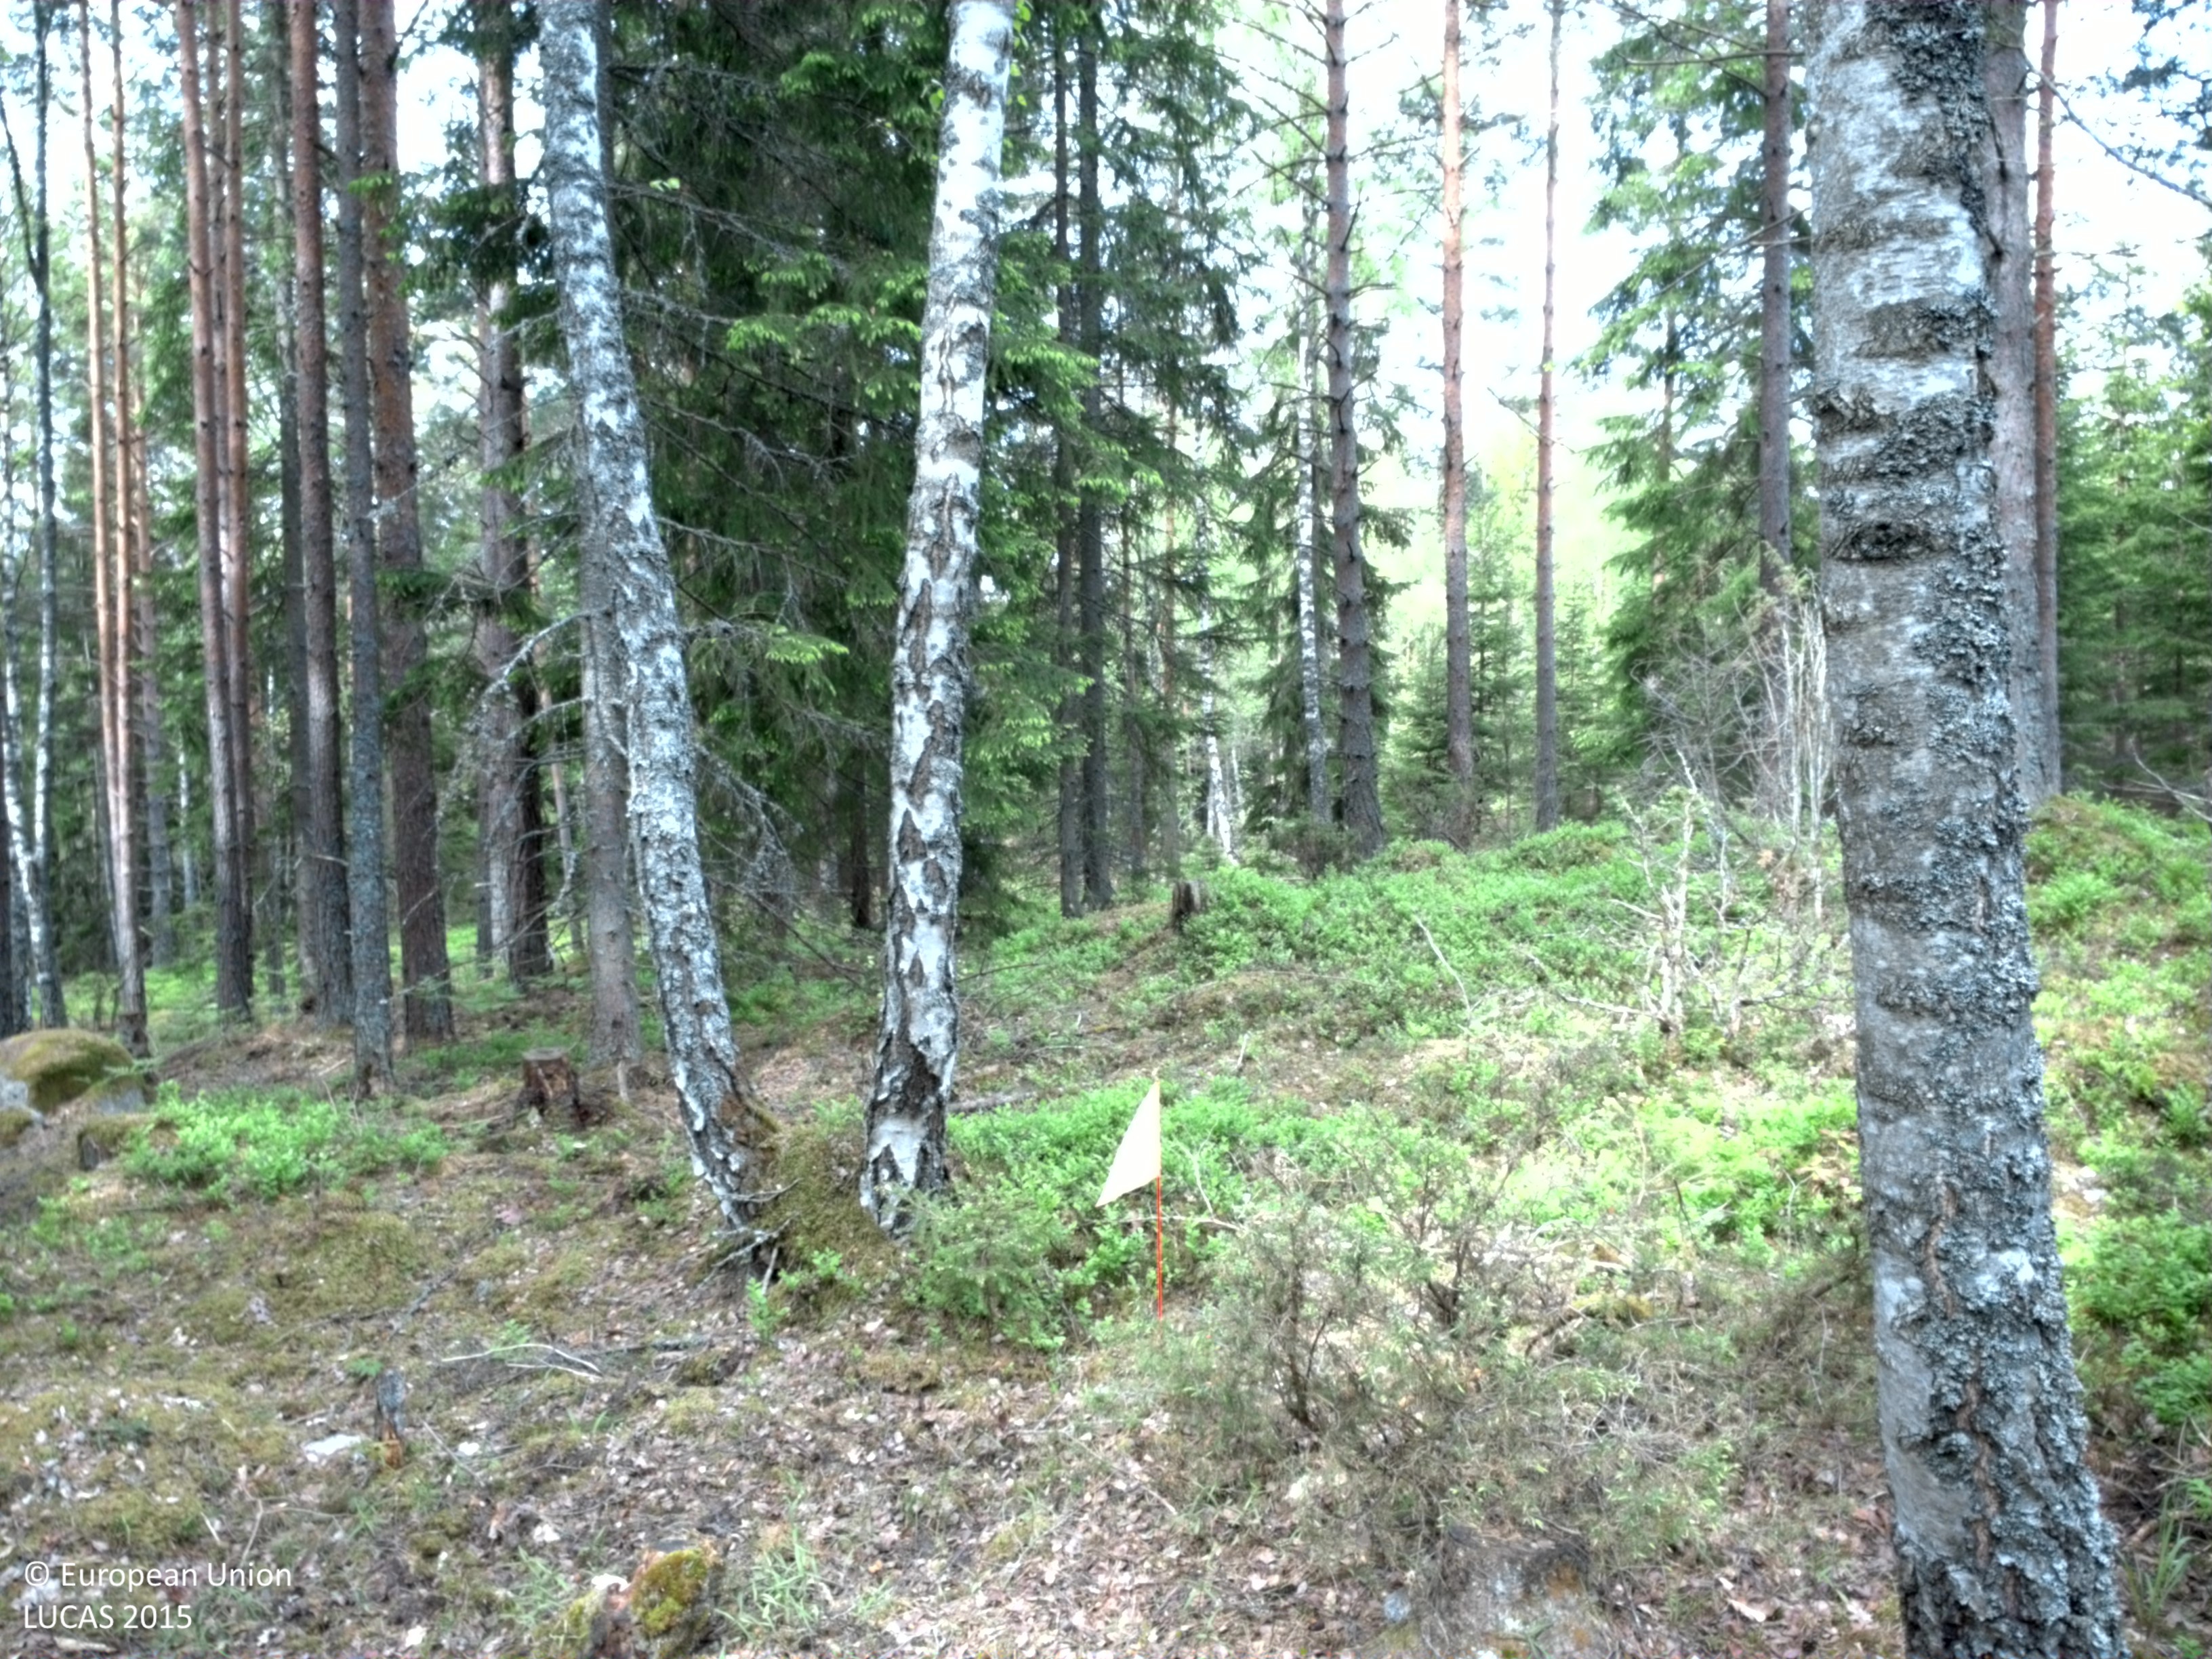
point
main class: Woodland
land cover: Pine dominated mixed woodland
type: boreal forest
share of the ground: 25 - 50 %
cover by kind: coniferous forest trees 25 %, broadleaved forest trees 25 %, shrubs 25 %, lichens and mosses 20 %, herbaceous plants 5 %
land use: Forestry
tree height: > 5 m
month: May
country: SE
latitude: 57.3456
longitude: 15.5973
